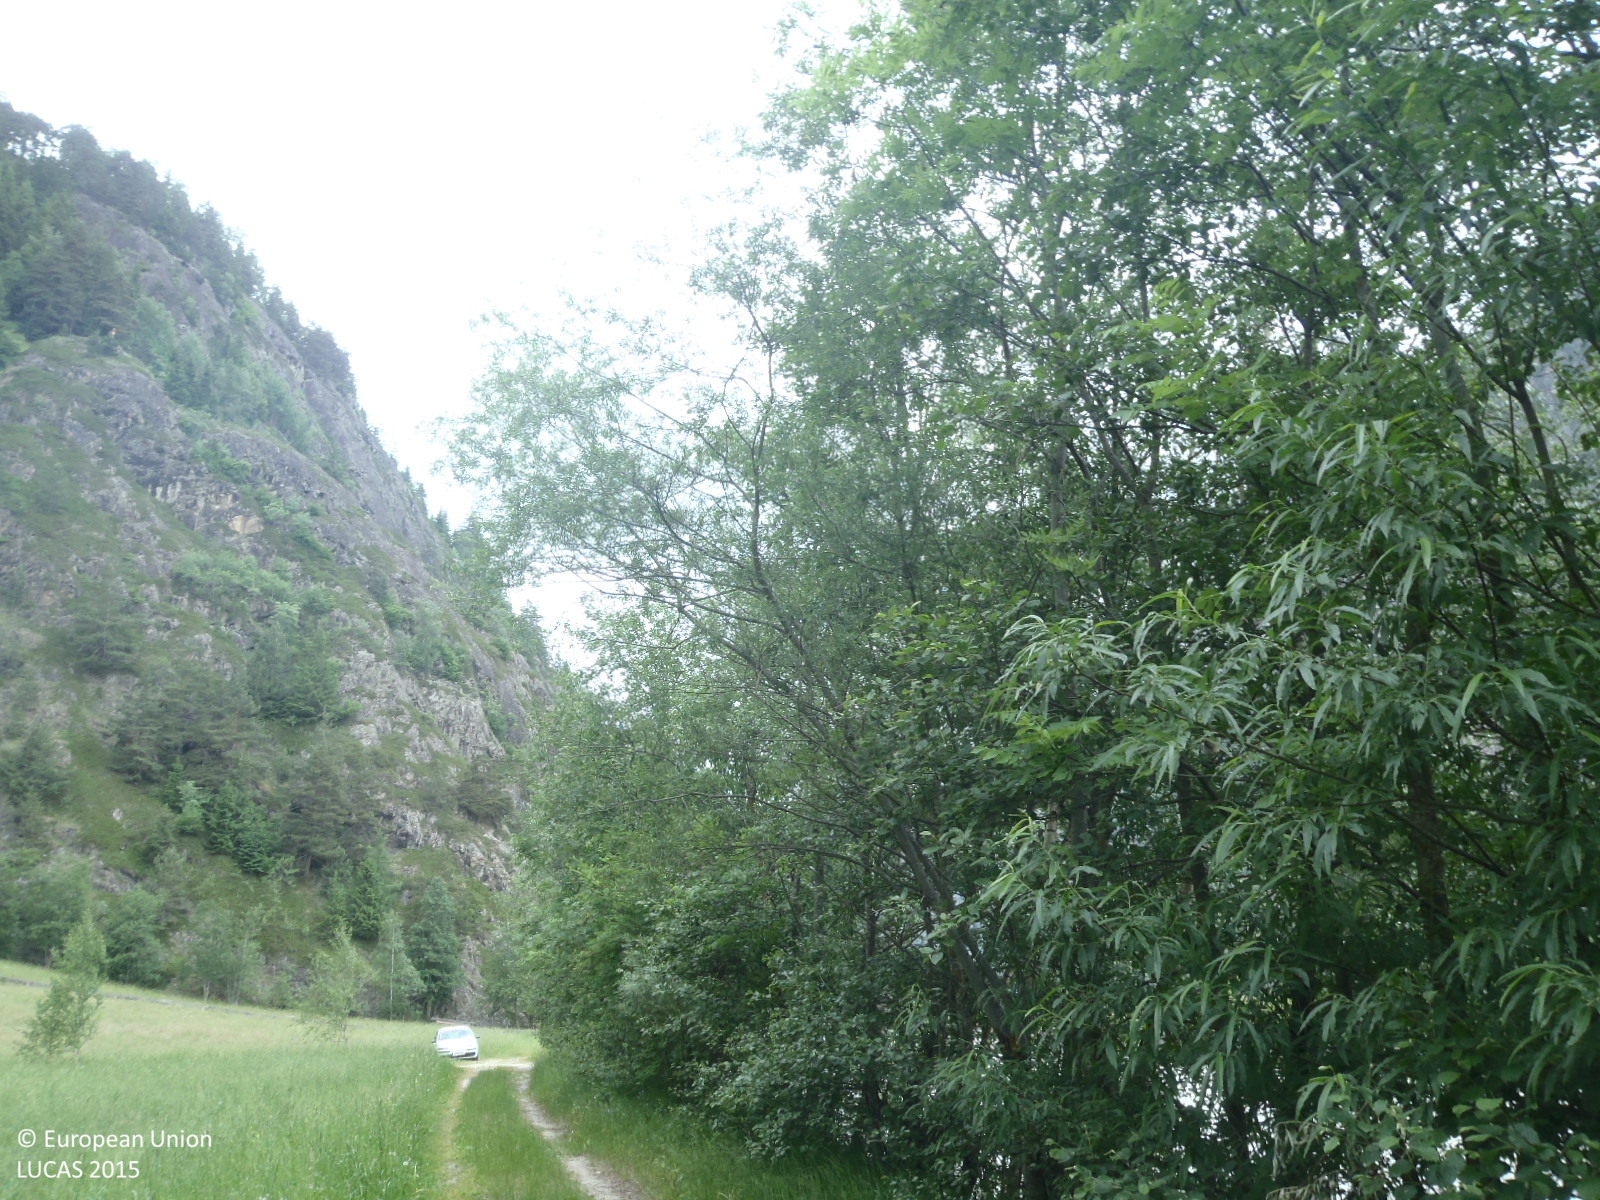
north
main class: Grassland
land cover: Grassland without tree/shrub cover
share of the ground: > 75 %
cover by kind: herbaceous plants 100 %
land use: Agriculture (excluding fallow land and kitchen gardens)
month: June
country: AT
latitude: 47.1578
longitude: 10.9092
